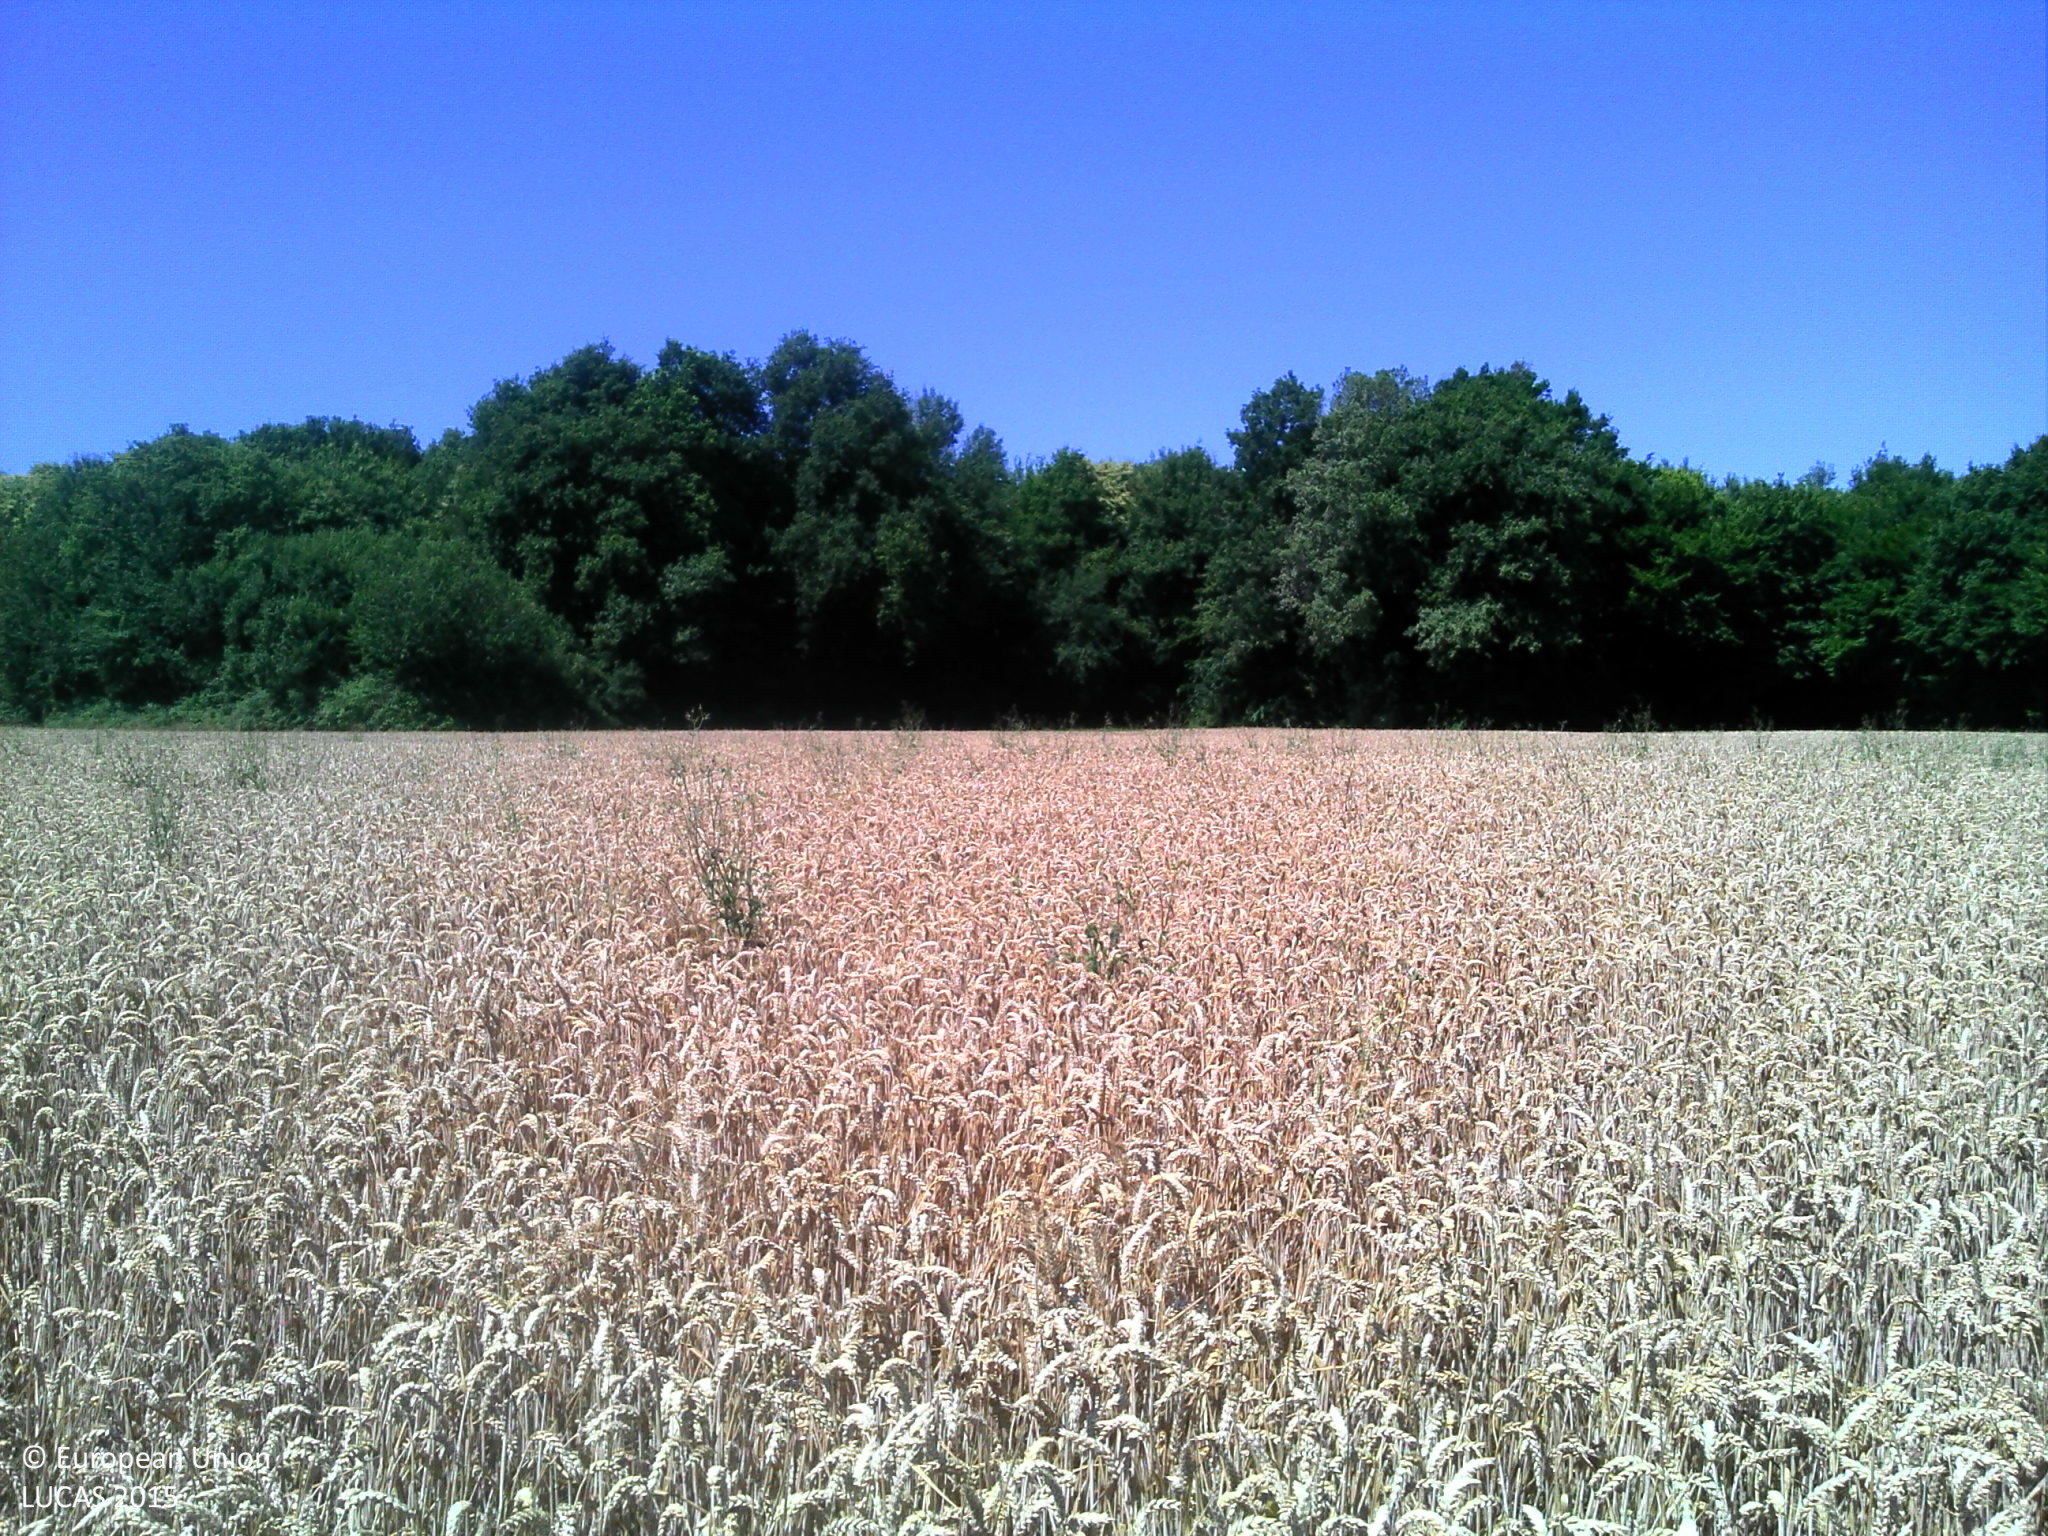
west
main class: Cropland
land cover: Common wheat
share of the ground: > 75 %
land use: Agriculture (excluding fallow land and kitchen gardens)
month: June
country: FR
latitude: 45.6863
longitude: -0.6945
